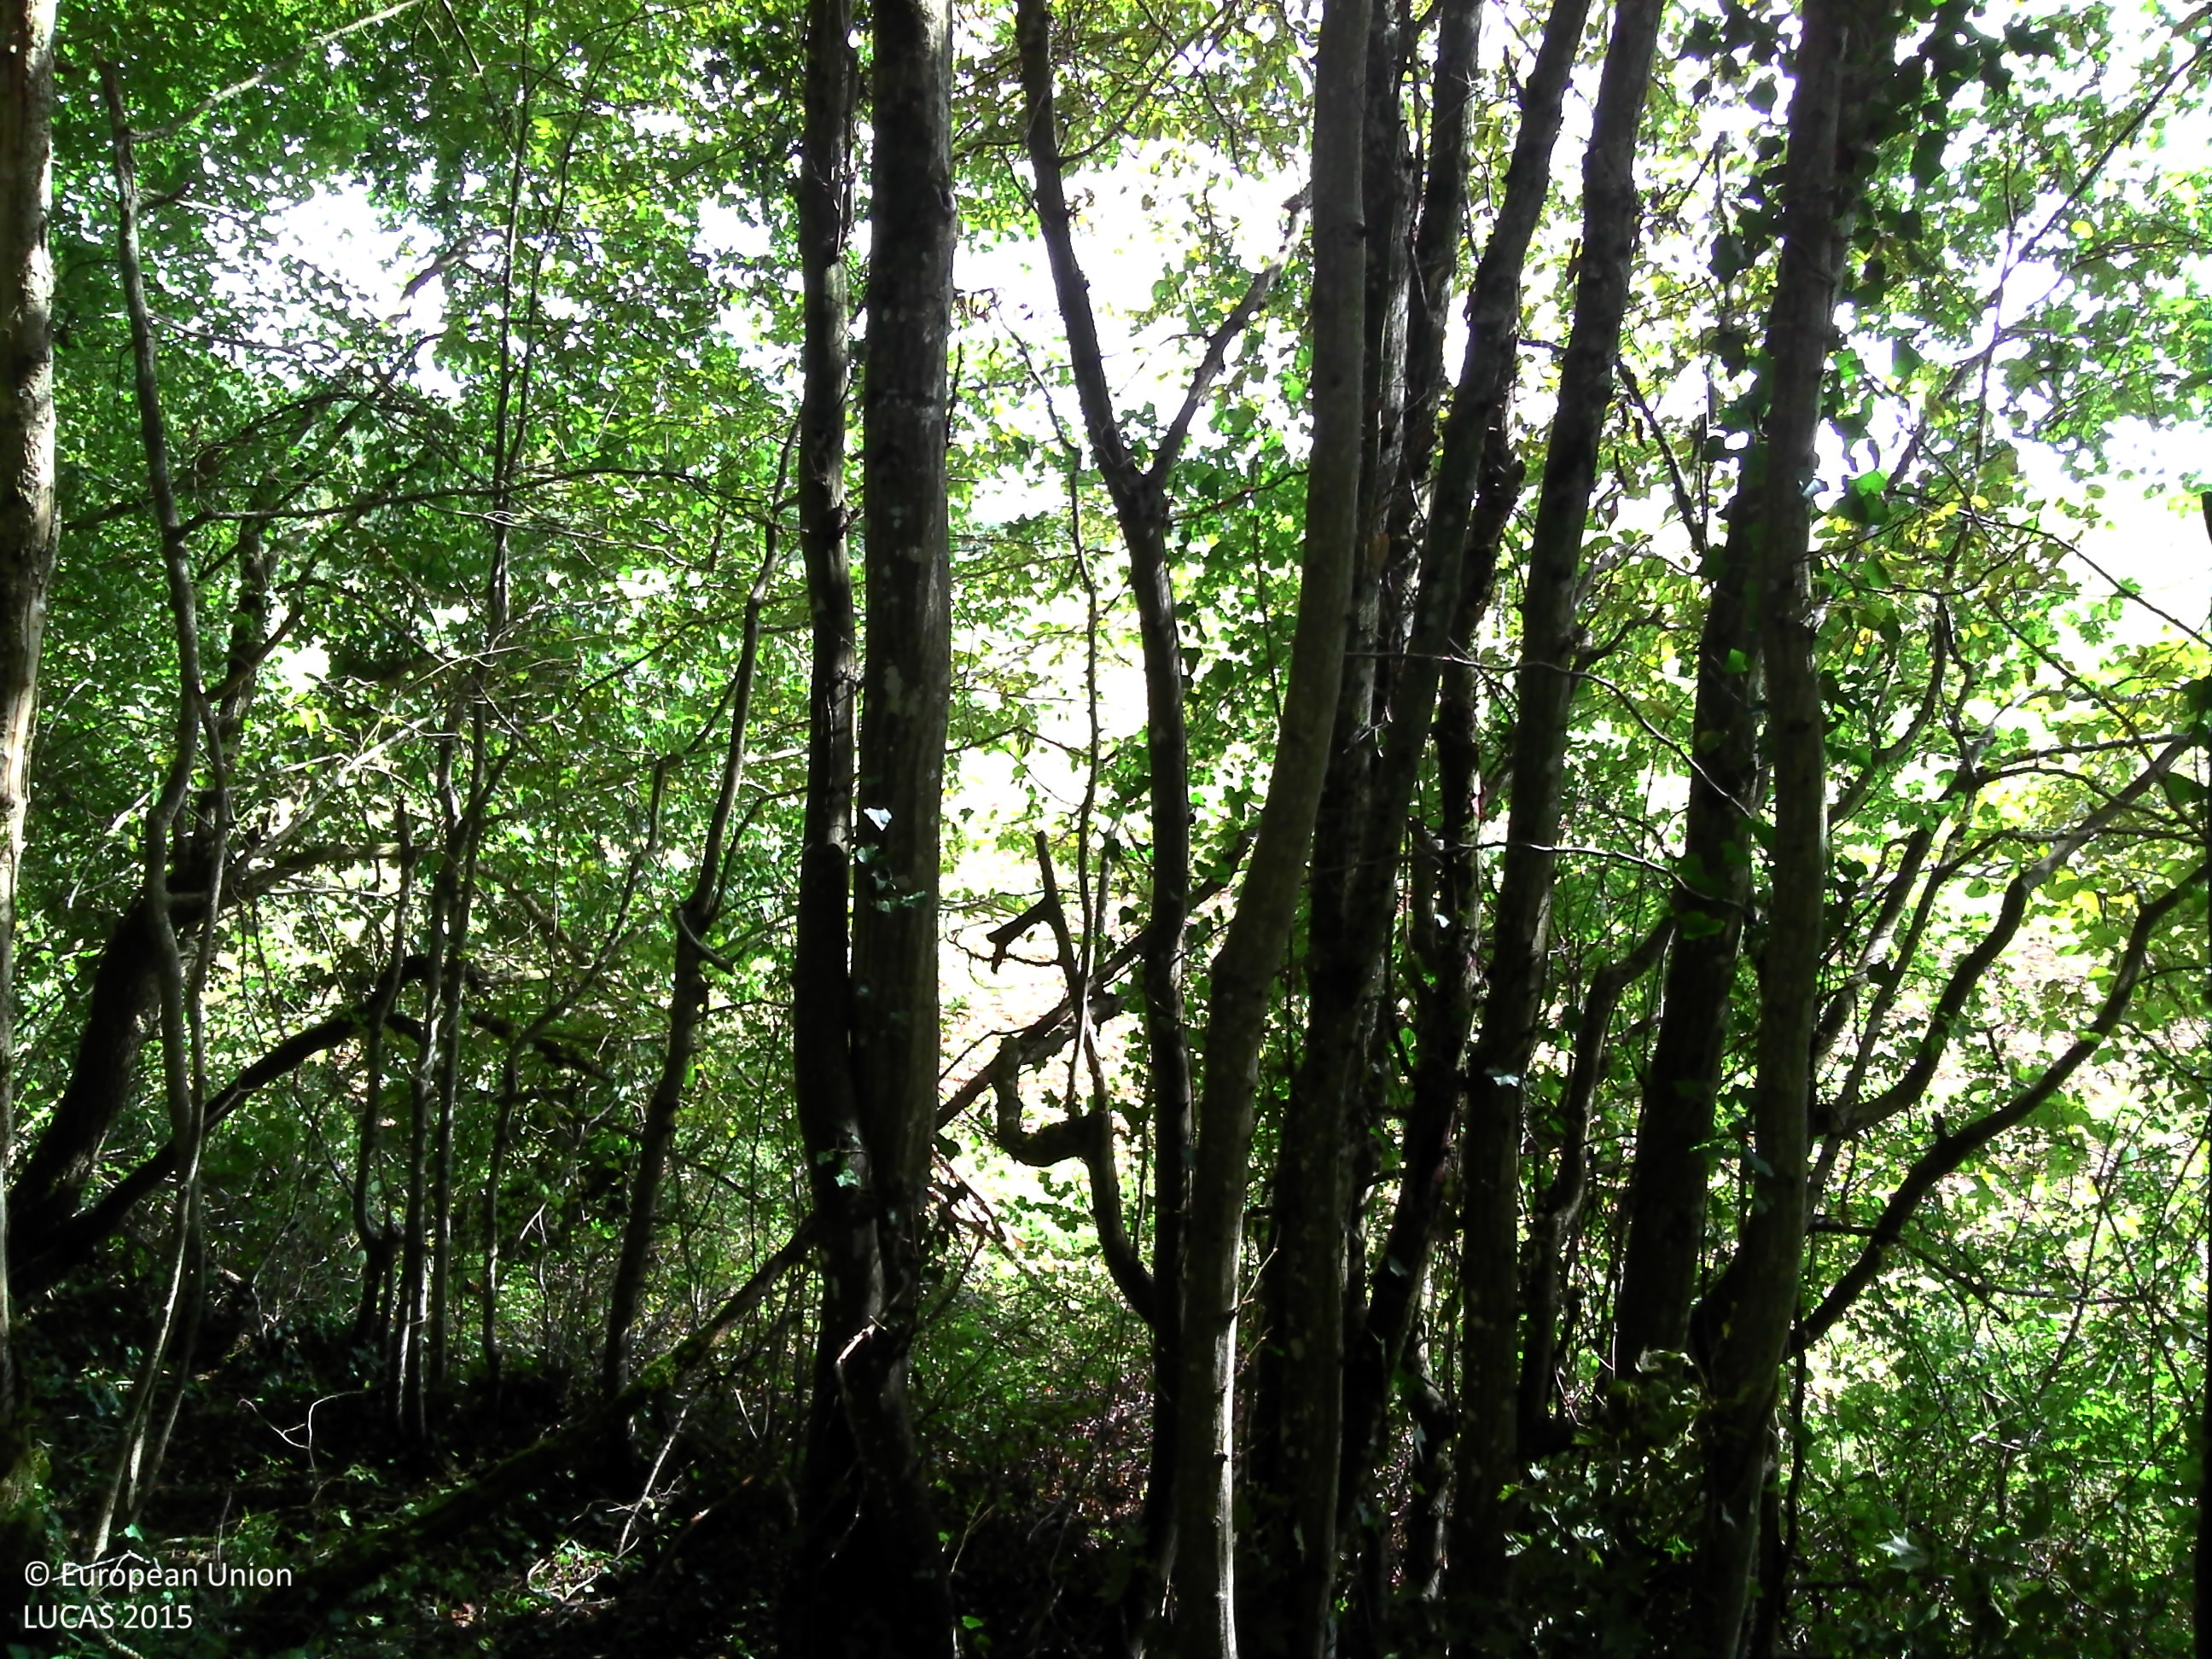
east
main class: Woodland
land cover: Broadleaved woodland
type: mesophytic deciduous forest
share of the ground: > 75 %
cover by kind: broadleaved forest trees 80 %, herbaceous plants 10 %, shrubs 5 %, lichens and mosses 5 %
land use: Forestry
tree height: > 5 m
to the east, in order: Broadleaved woodland; Rape and turnip rape; Grass margins; Broadleaved woodland
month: September
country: FR
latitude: 48.2919
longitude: 4.6469
